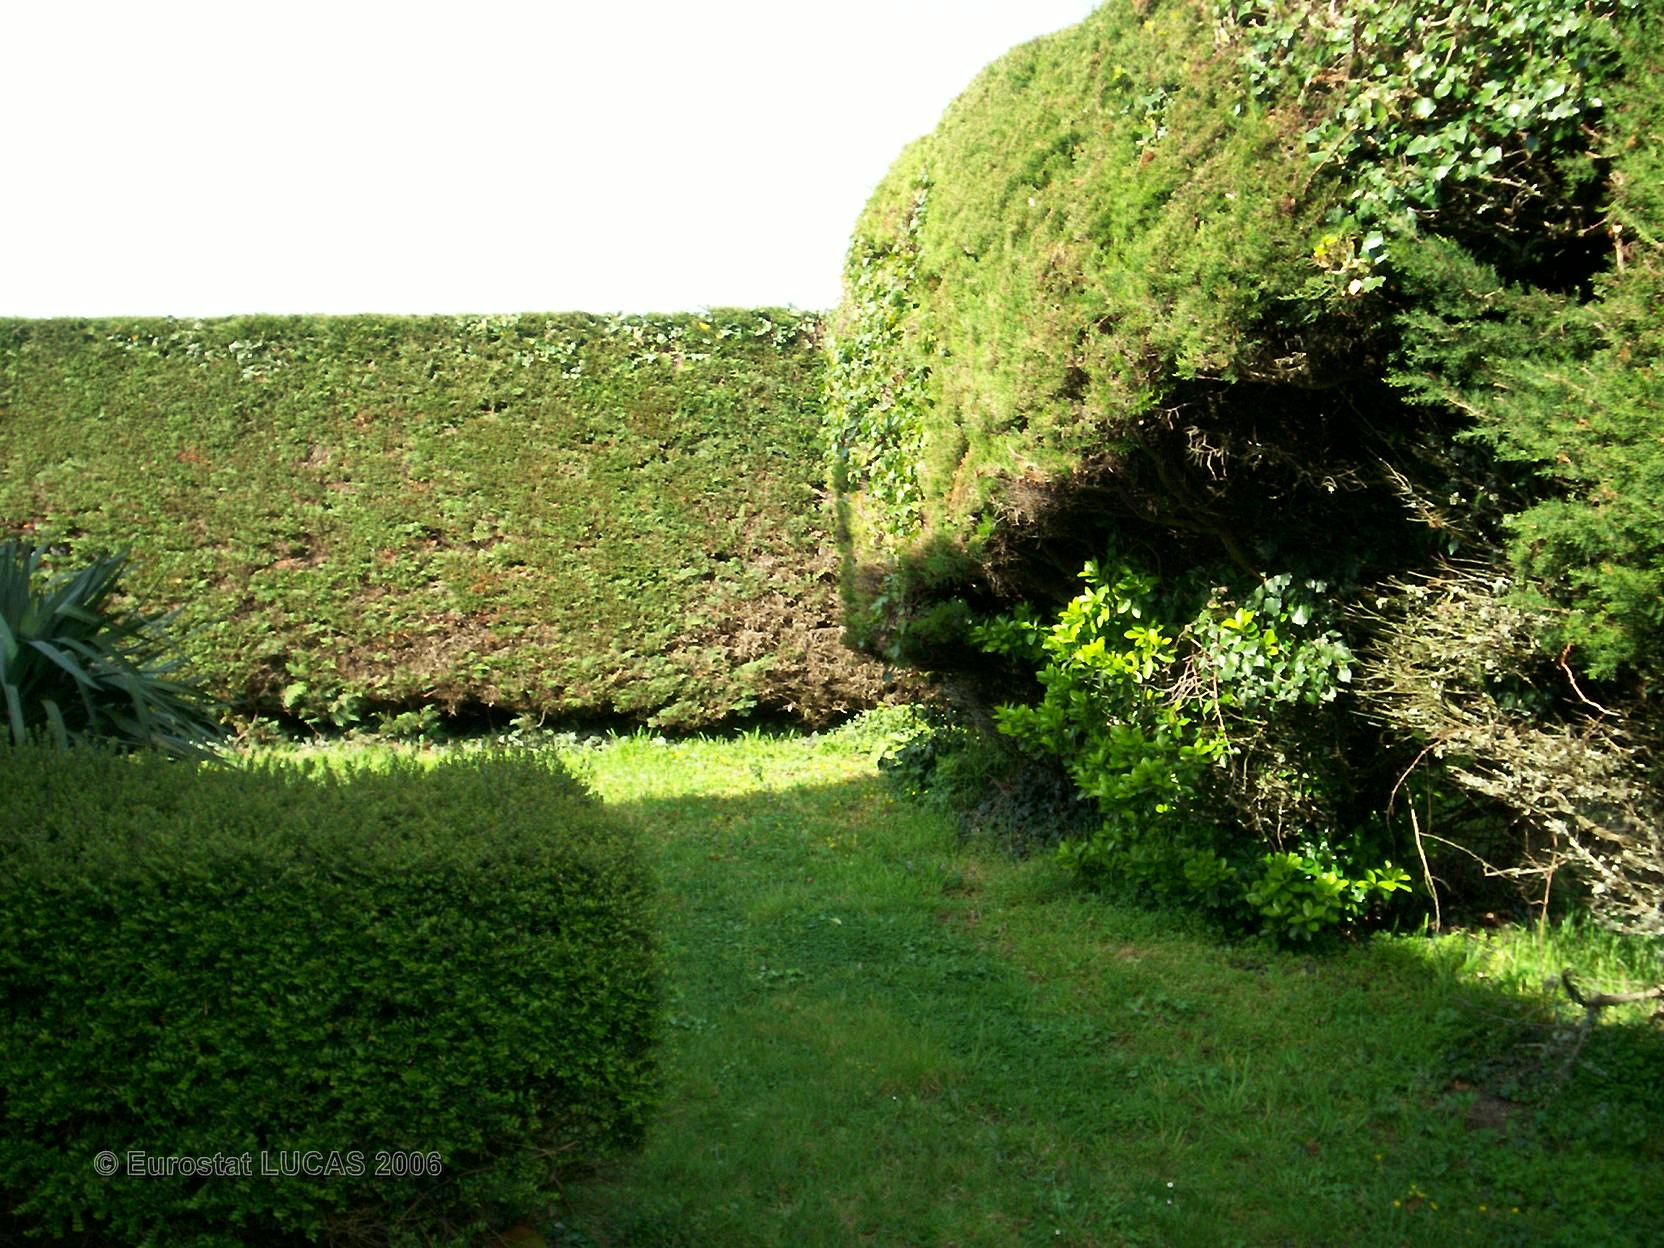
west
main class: Grassland
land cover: Grassland without tree/shrub cover
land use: Residential
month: April
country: FR
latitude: 47.7059
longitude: -3.4411
